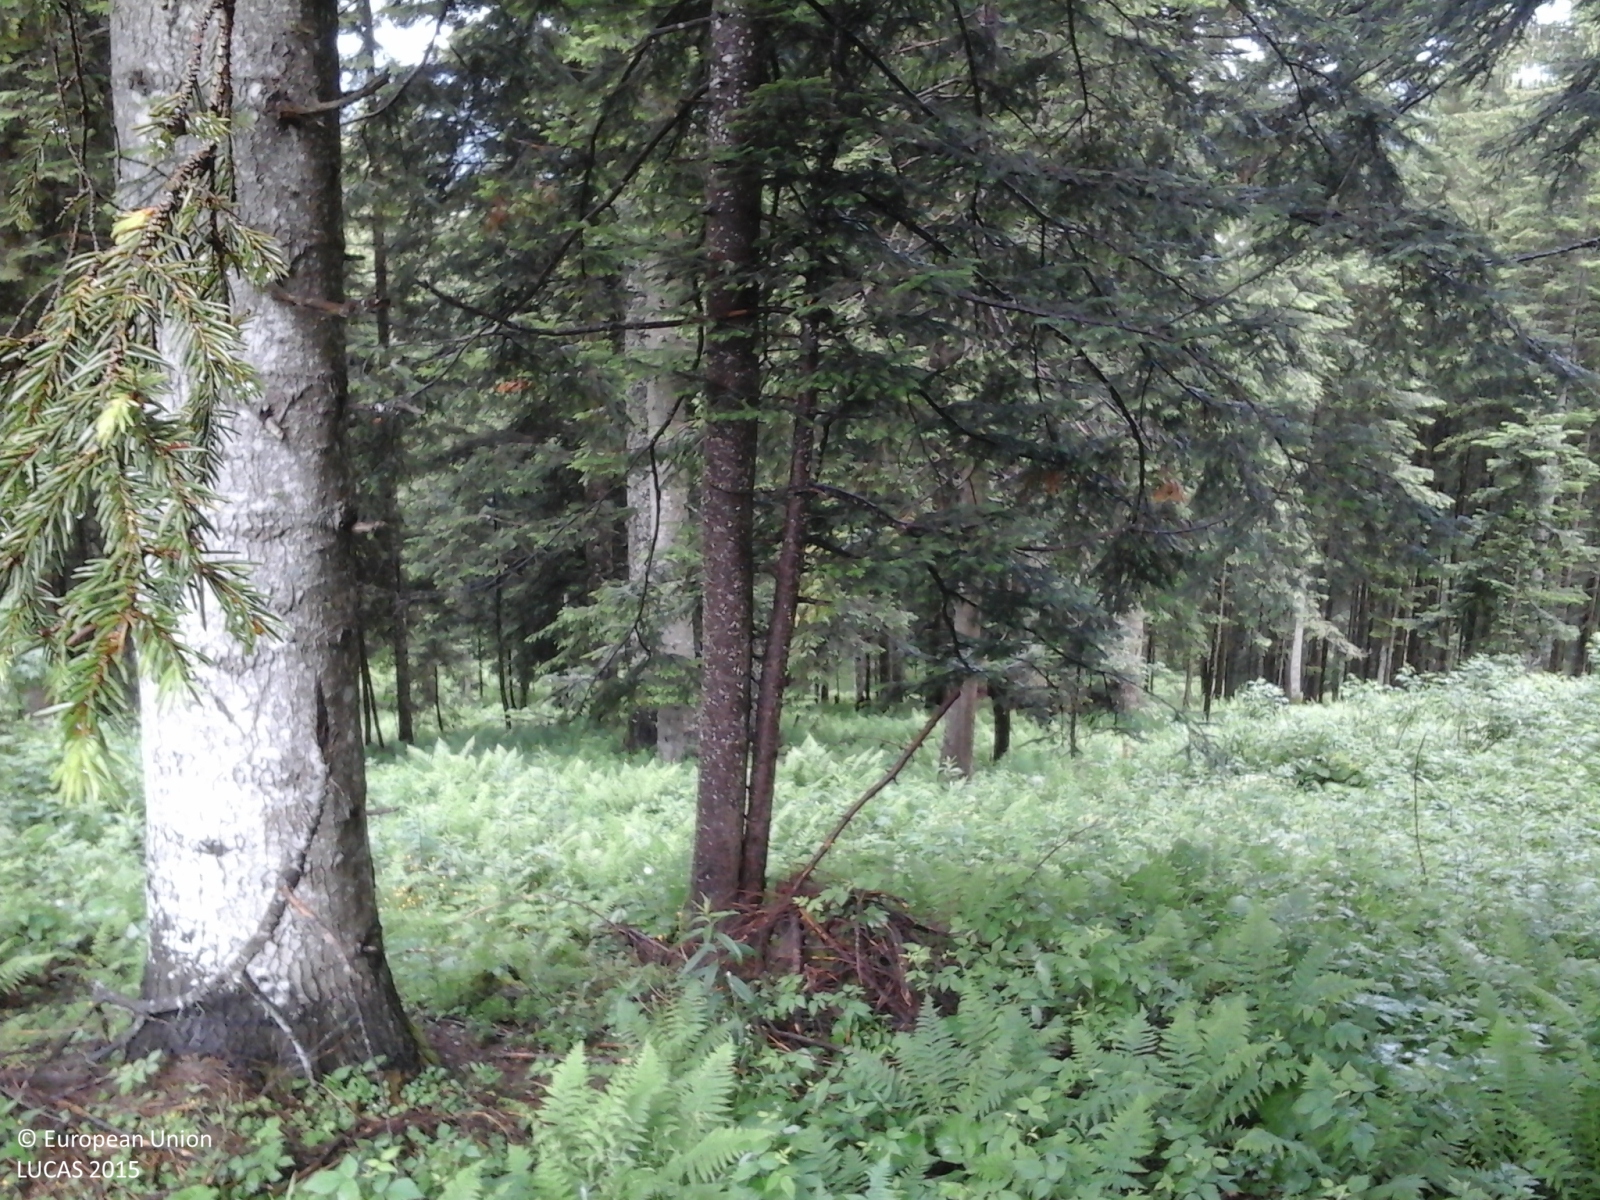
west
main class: Woodland
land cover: Spruce dominated coniferous woodland
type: alpine coniferous forest
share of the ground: > 75 %
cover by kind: coniferous forest trees 100 %
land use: Forestry
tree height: > 5 m
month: June
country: IT
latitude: 45.9787
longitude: 11.6112
